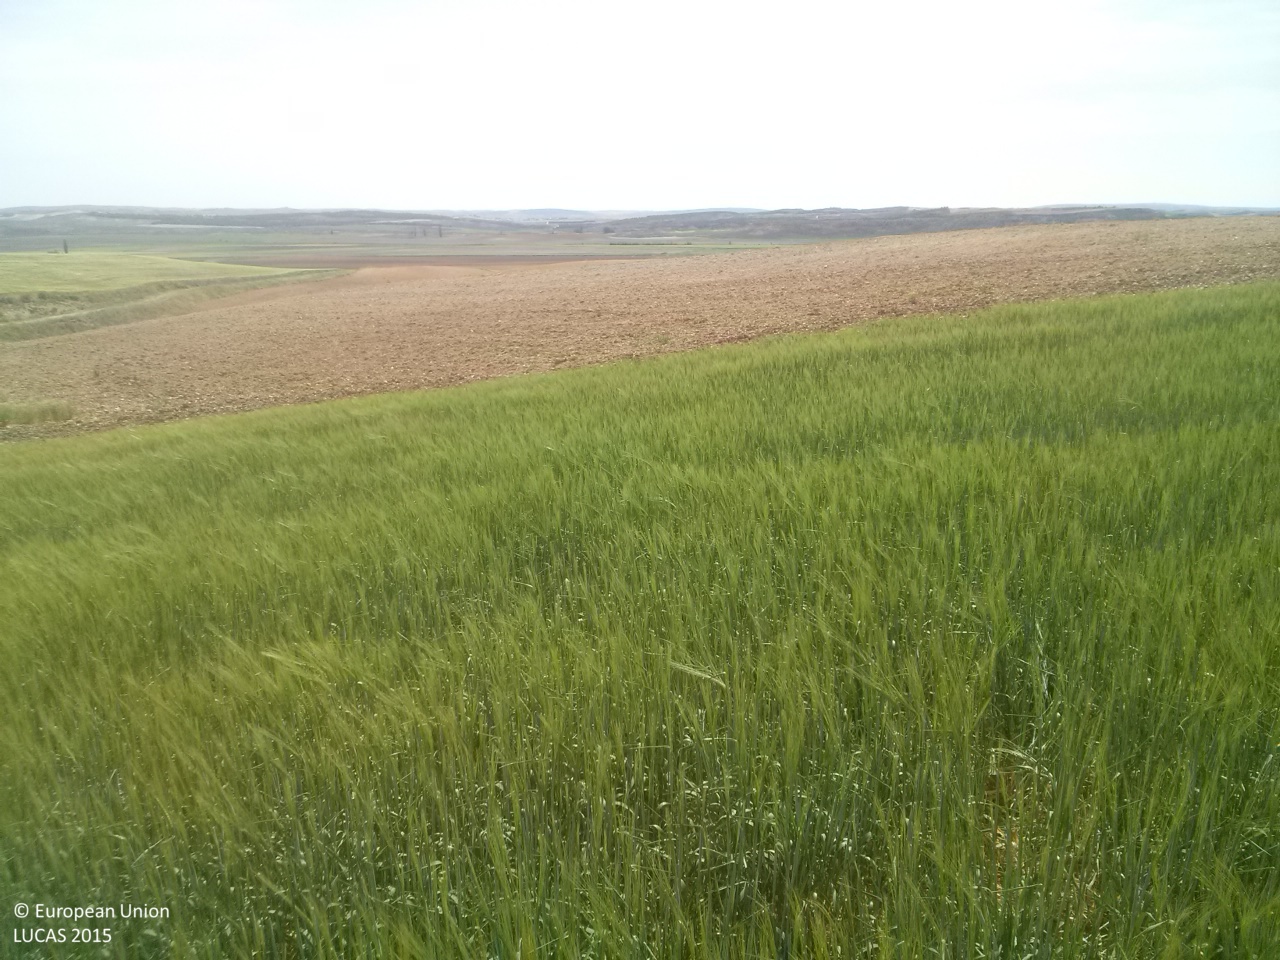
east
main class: Cropland
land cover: Barley
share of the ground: > 75 %
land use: Agriculture (excluding fallow land and kitchen gardens)
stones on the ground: 25 - 50 %
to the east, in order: Barley; Spontaneously vegetated surfaces; Other bare soil
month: May
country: ES
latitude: 39.7758
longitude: -2.6378
